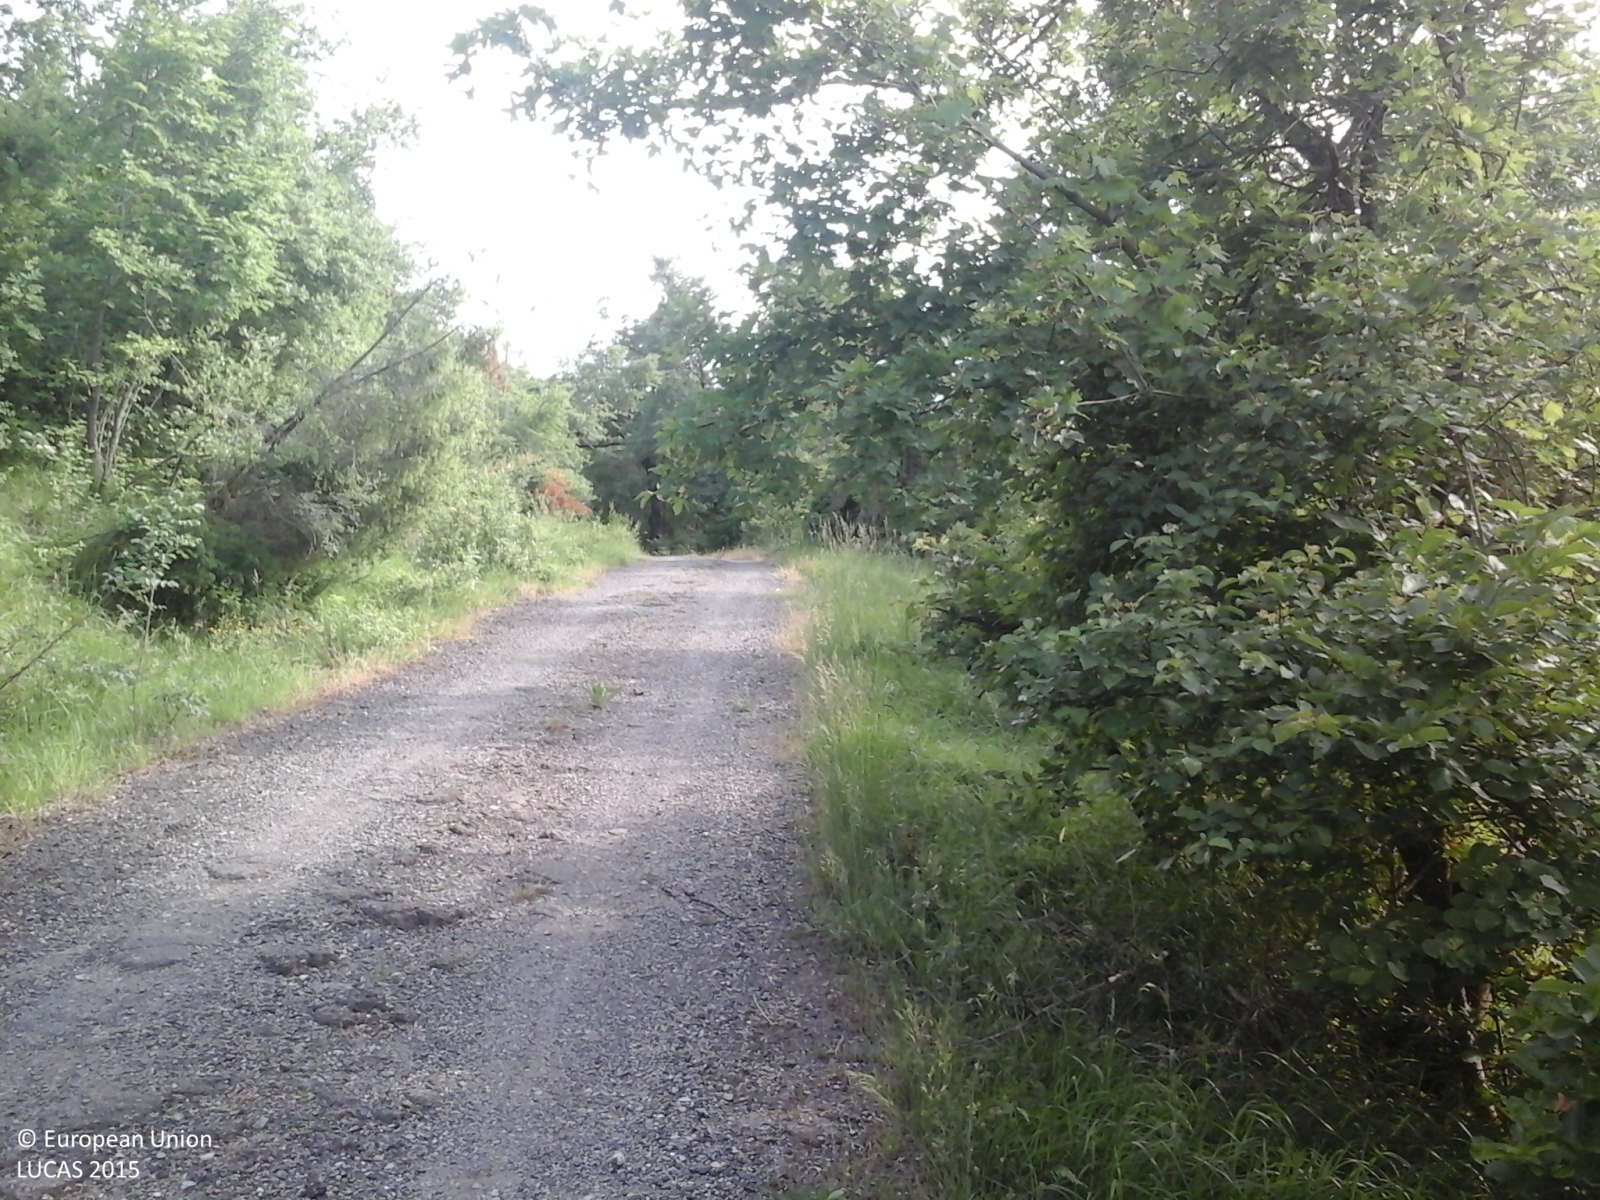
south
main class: Woodland
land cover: Broadleaved woodland
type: thermophilous deciduous forest
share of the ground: > 75 %
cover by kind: broadleaved forest trees 85 %, shrubs 10 %, herbaceous plants 5 %
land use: Forestry
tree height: > 5 m
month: May
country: IT
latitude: 44.2355
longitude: 11.1867
